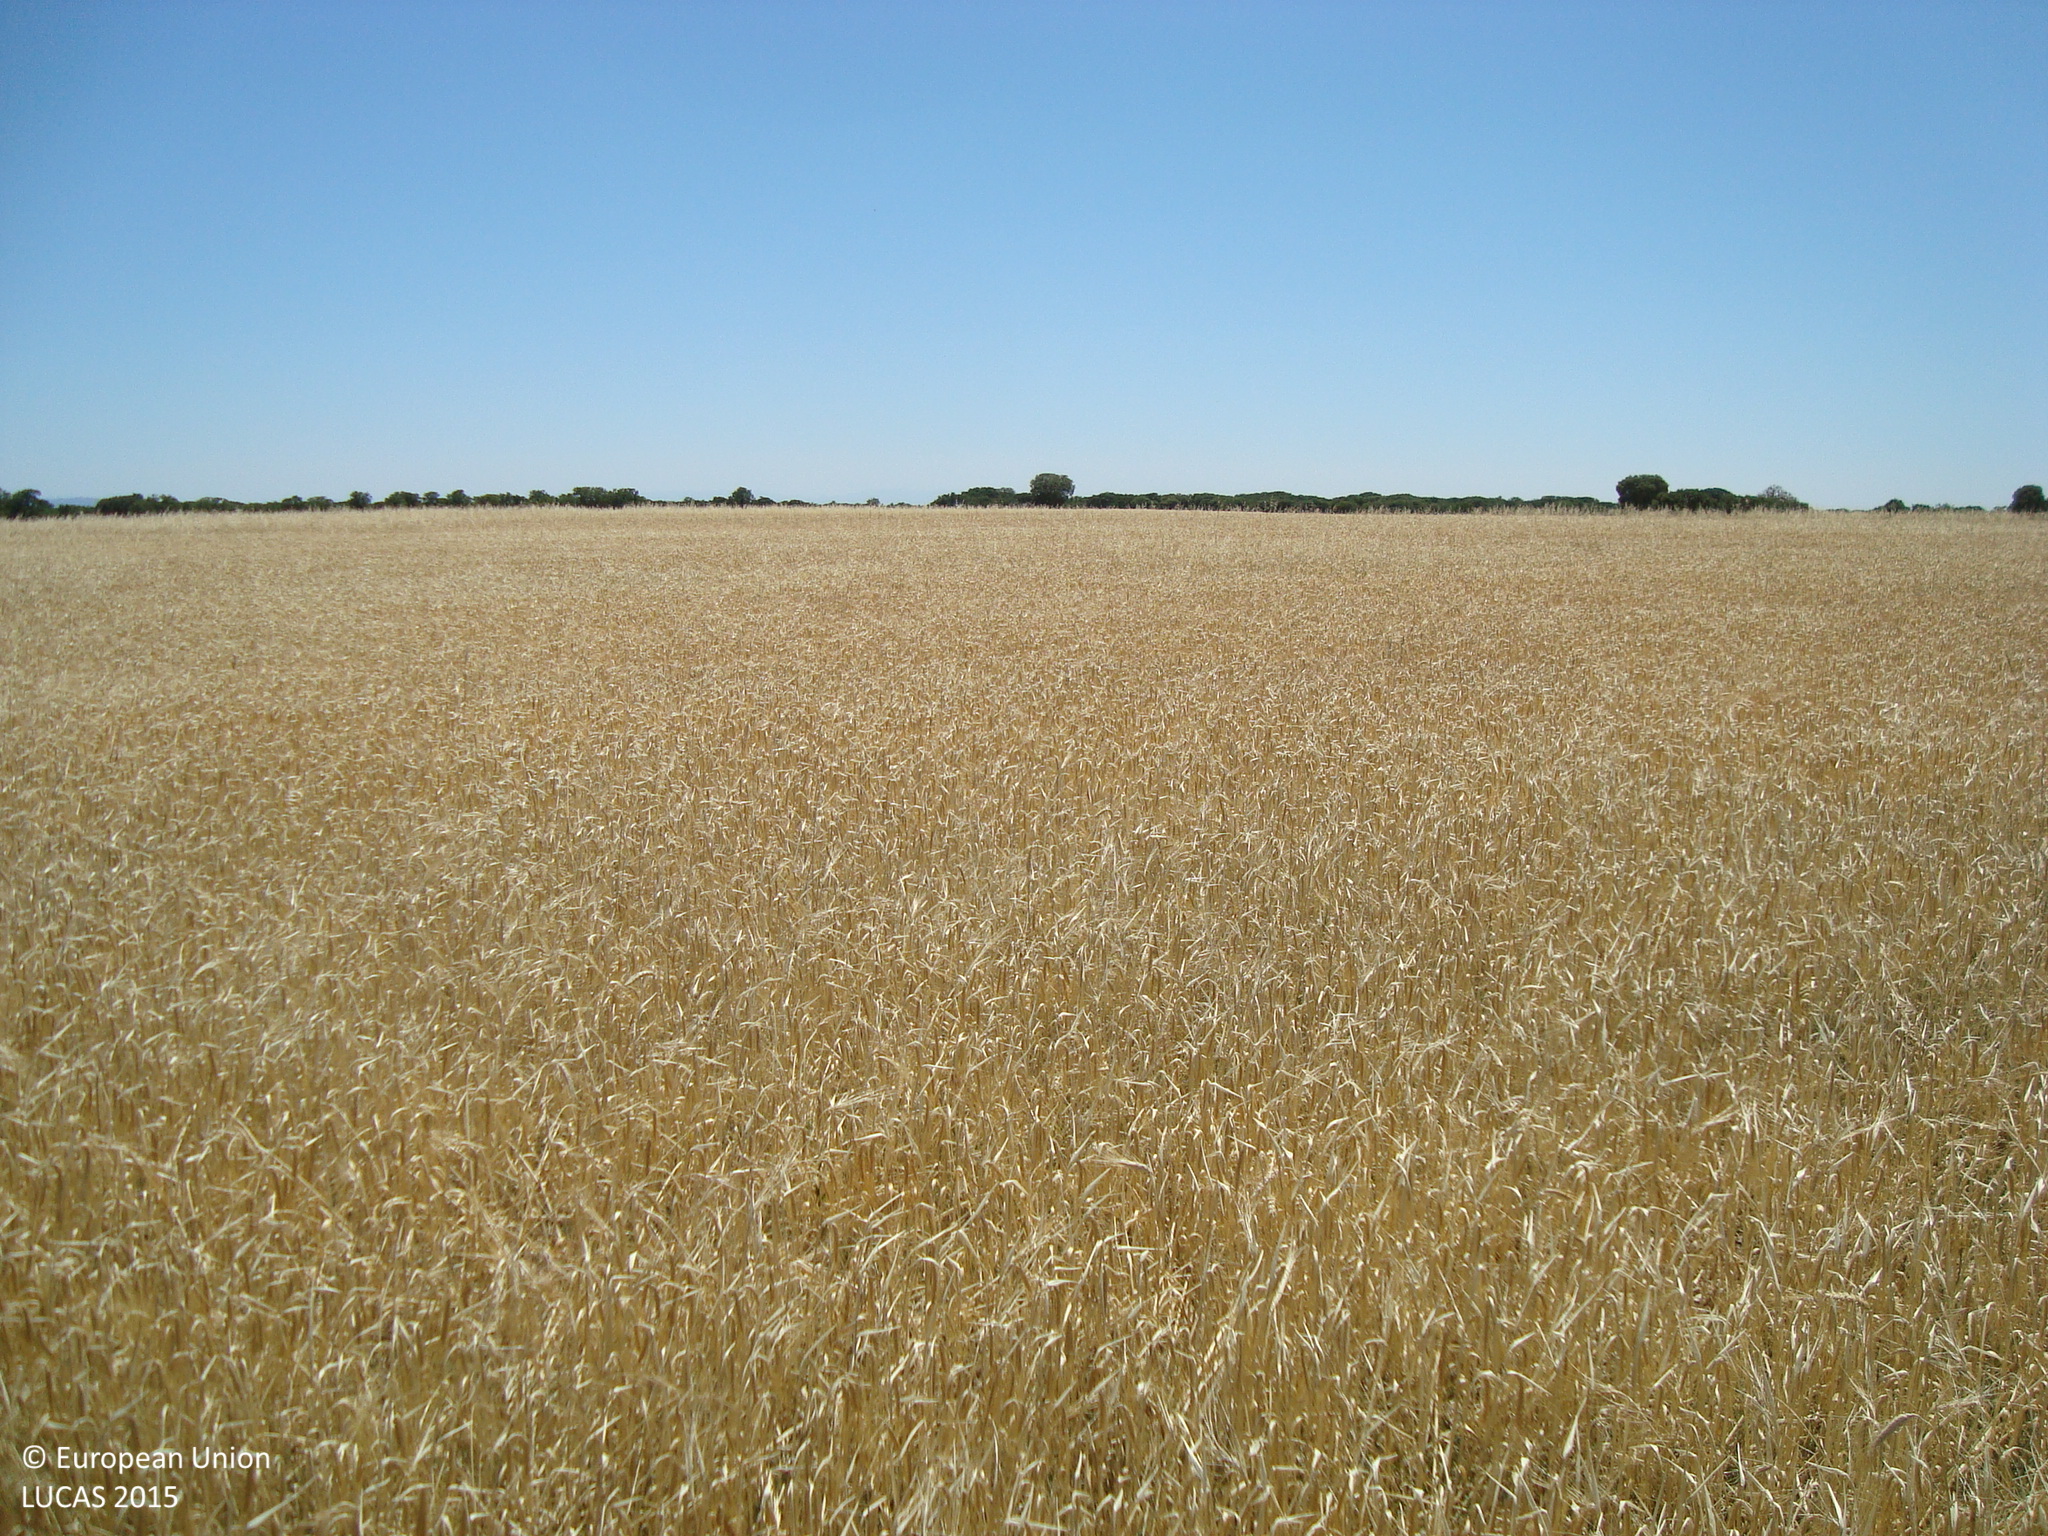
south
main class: Cropland
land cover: Barley
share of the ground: > 75 %
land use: Agriculture (excluding fallow land and kitchen gardens)
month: July
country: ES
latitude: 41.6724
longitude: -4.0271
